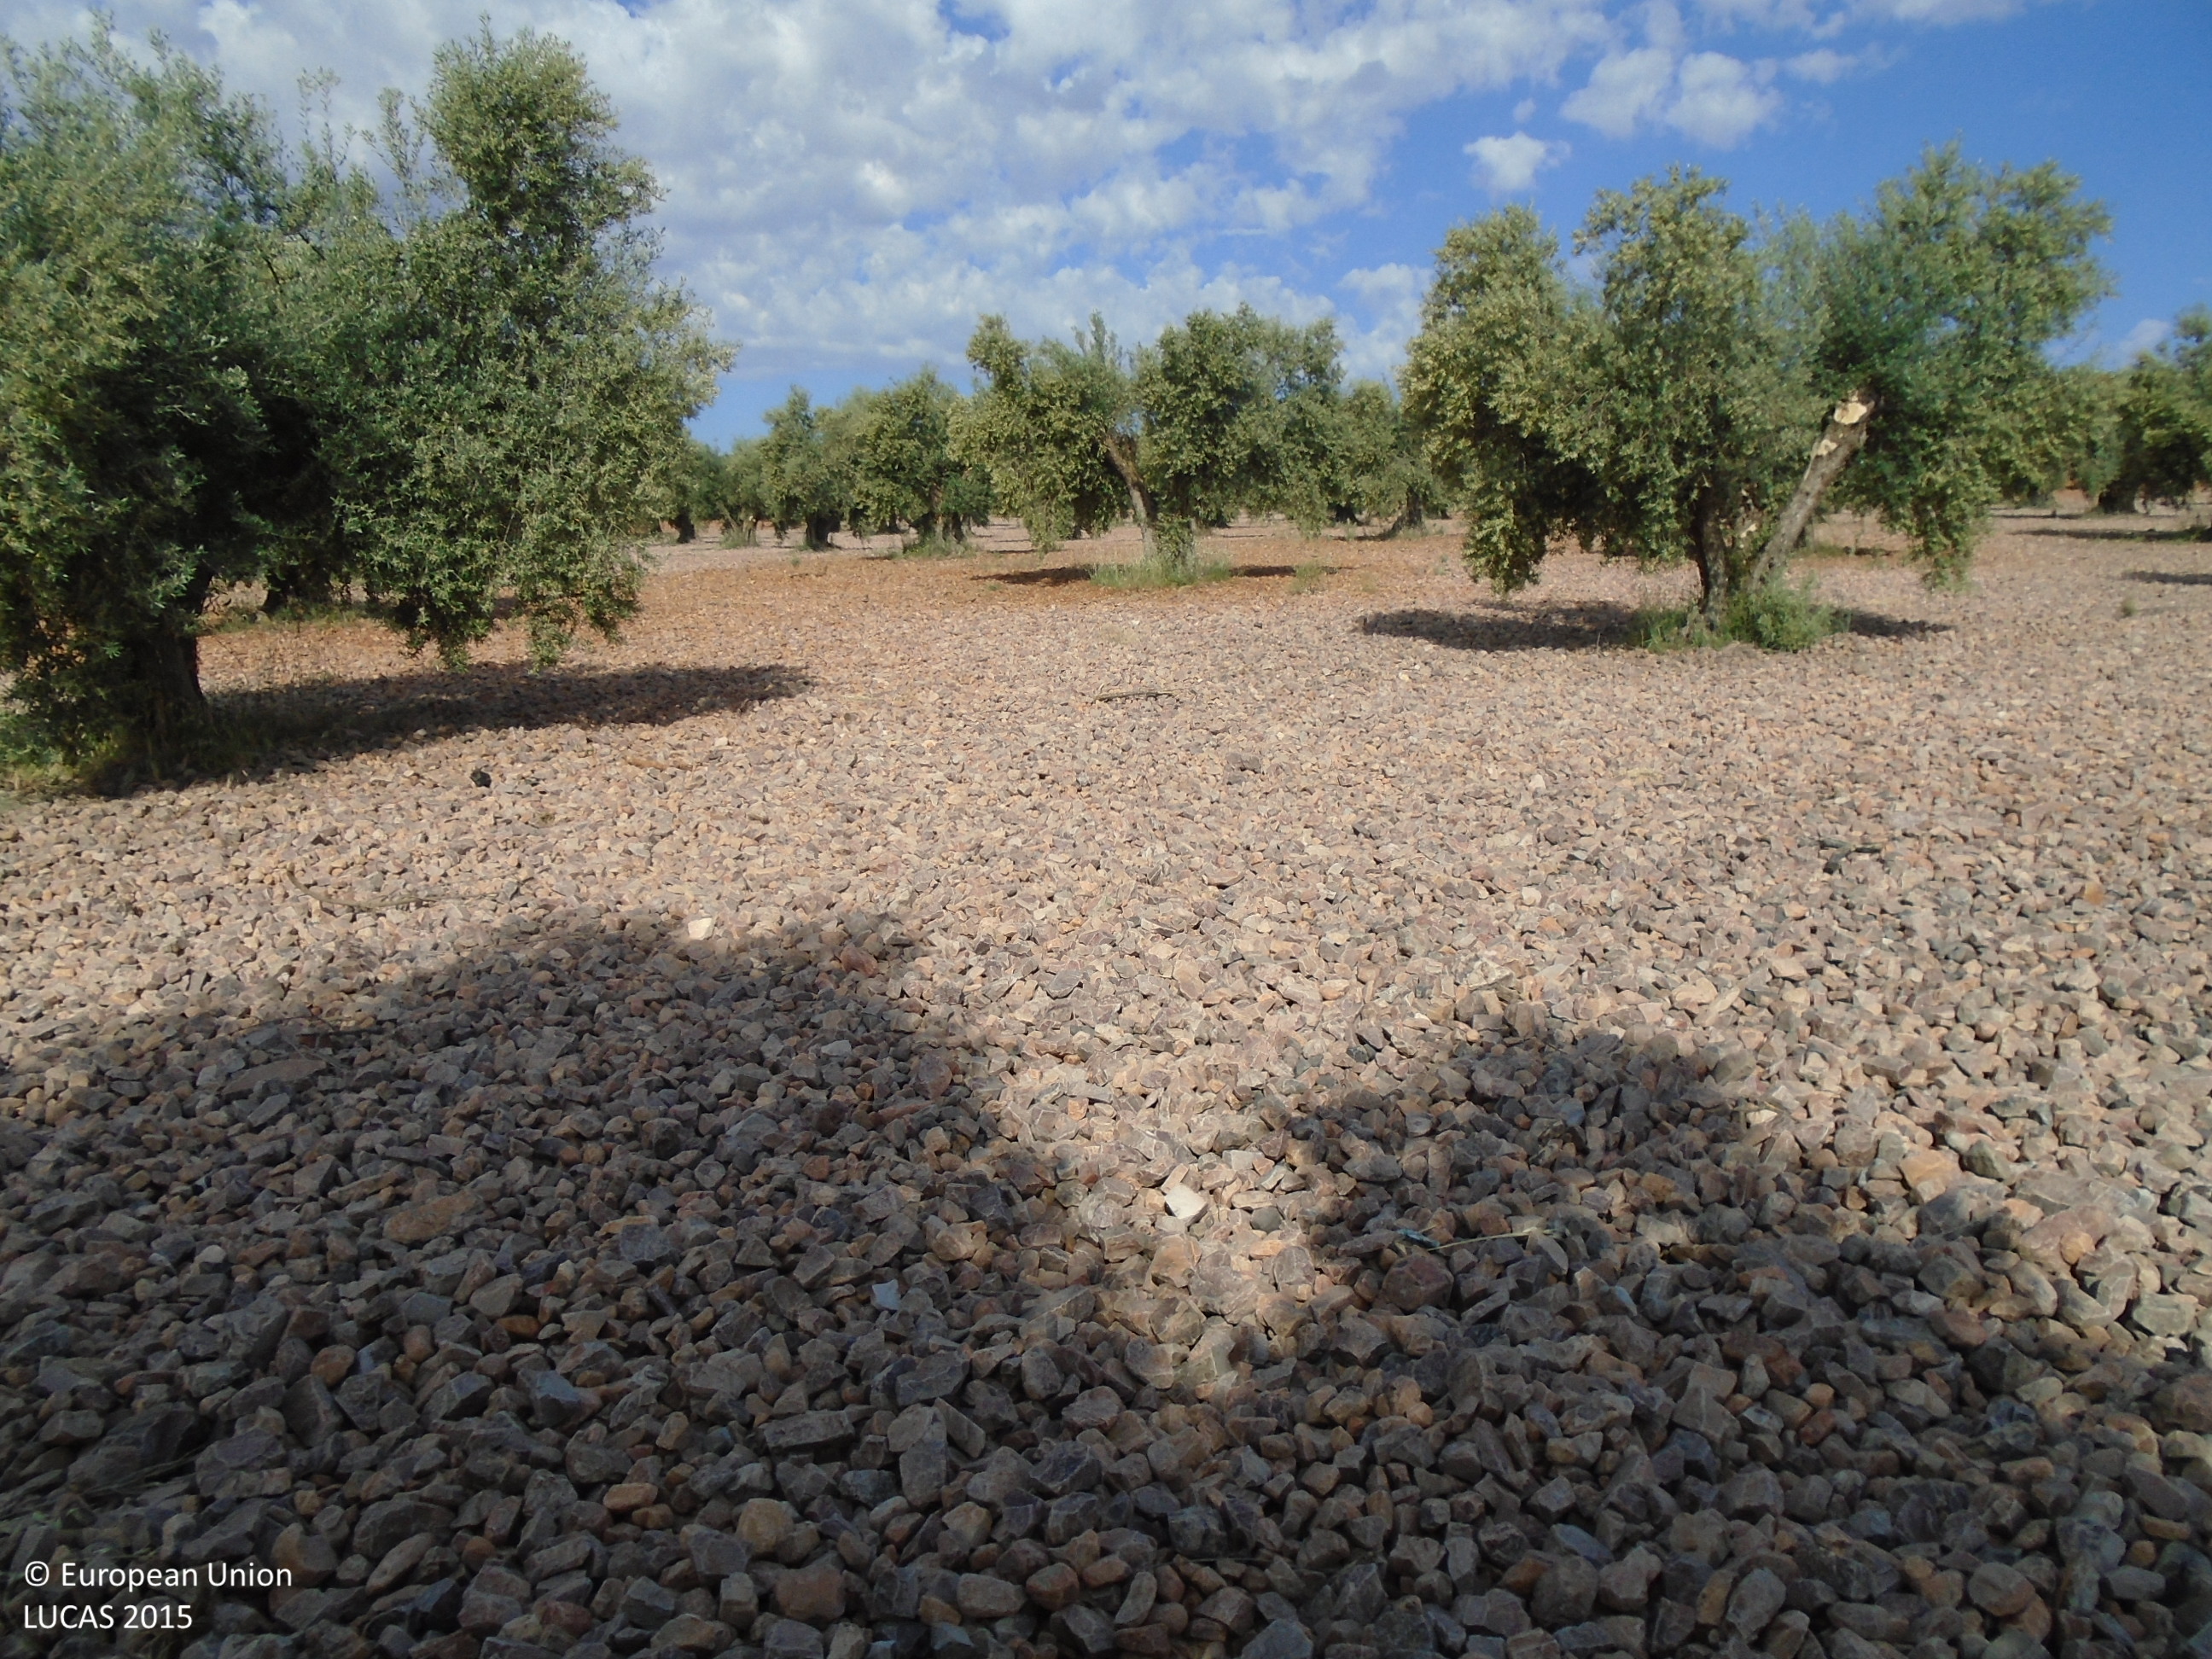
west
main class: Cropland
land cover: Olive groves
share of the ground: 10 - 25 %
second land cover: Other bare soil
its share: > 75 %
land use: Agriculture (excluding fallow land and kitchen gardens)
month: May
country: ES
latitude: 39.5900
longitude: -3.7317
